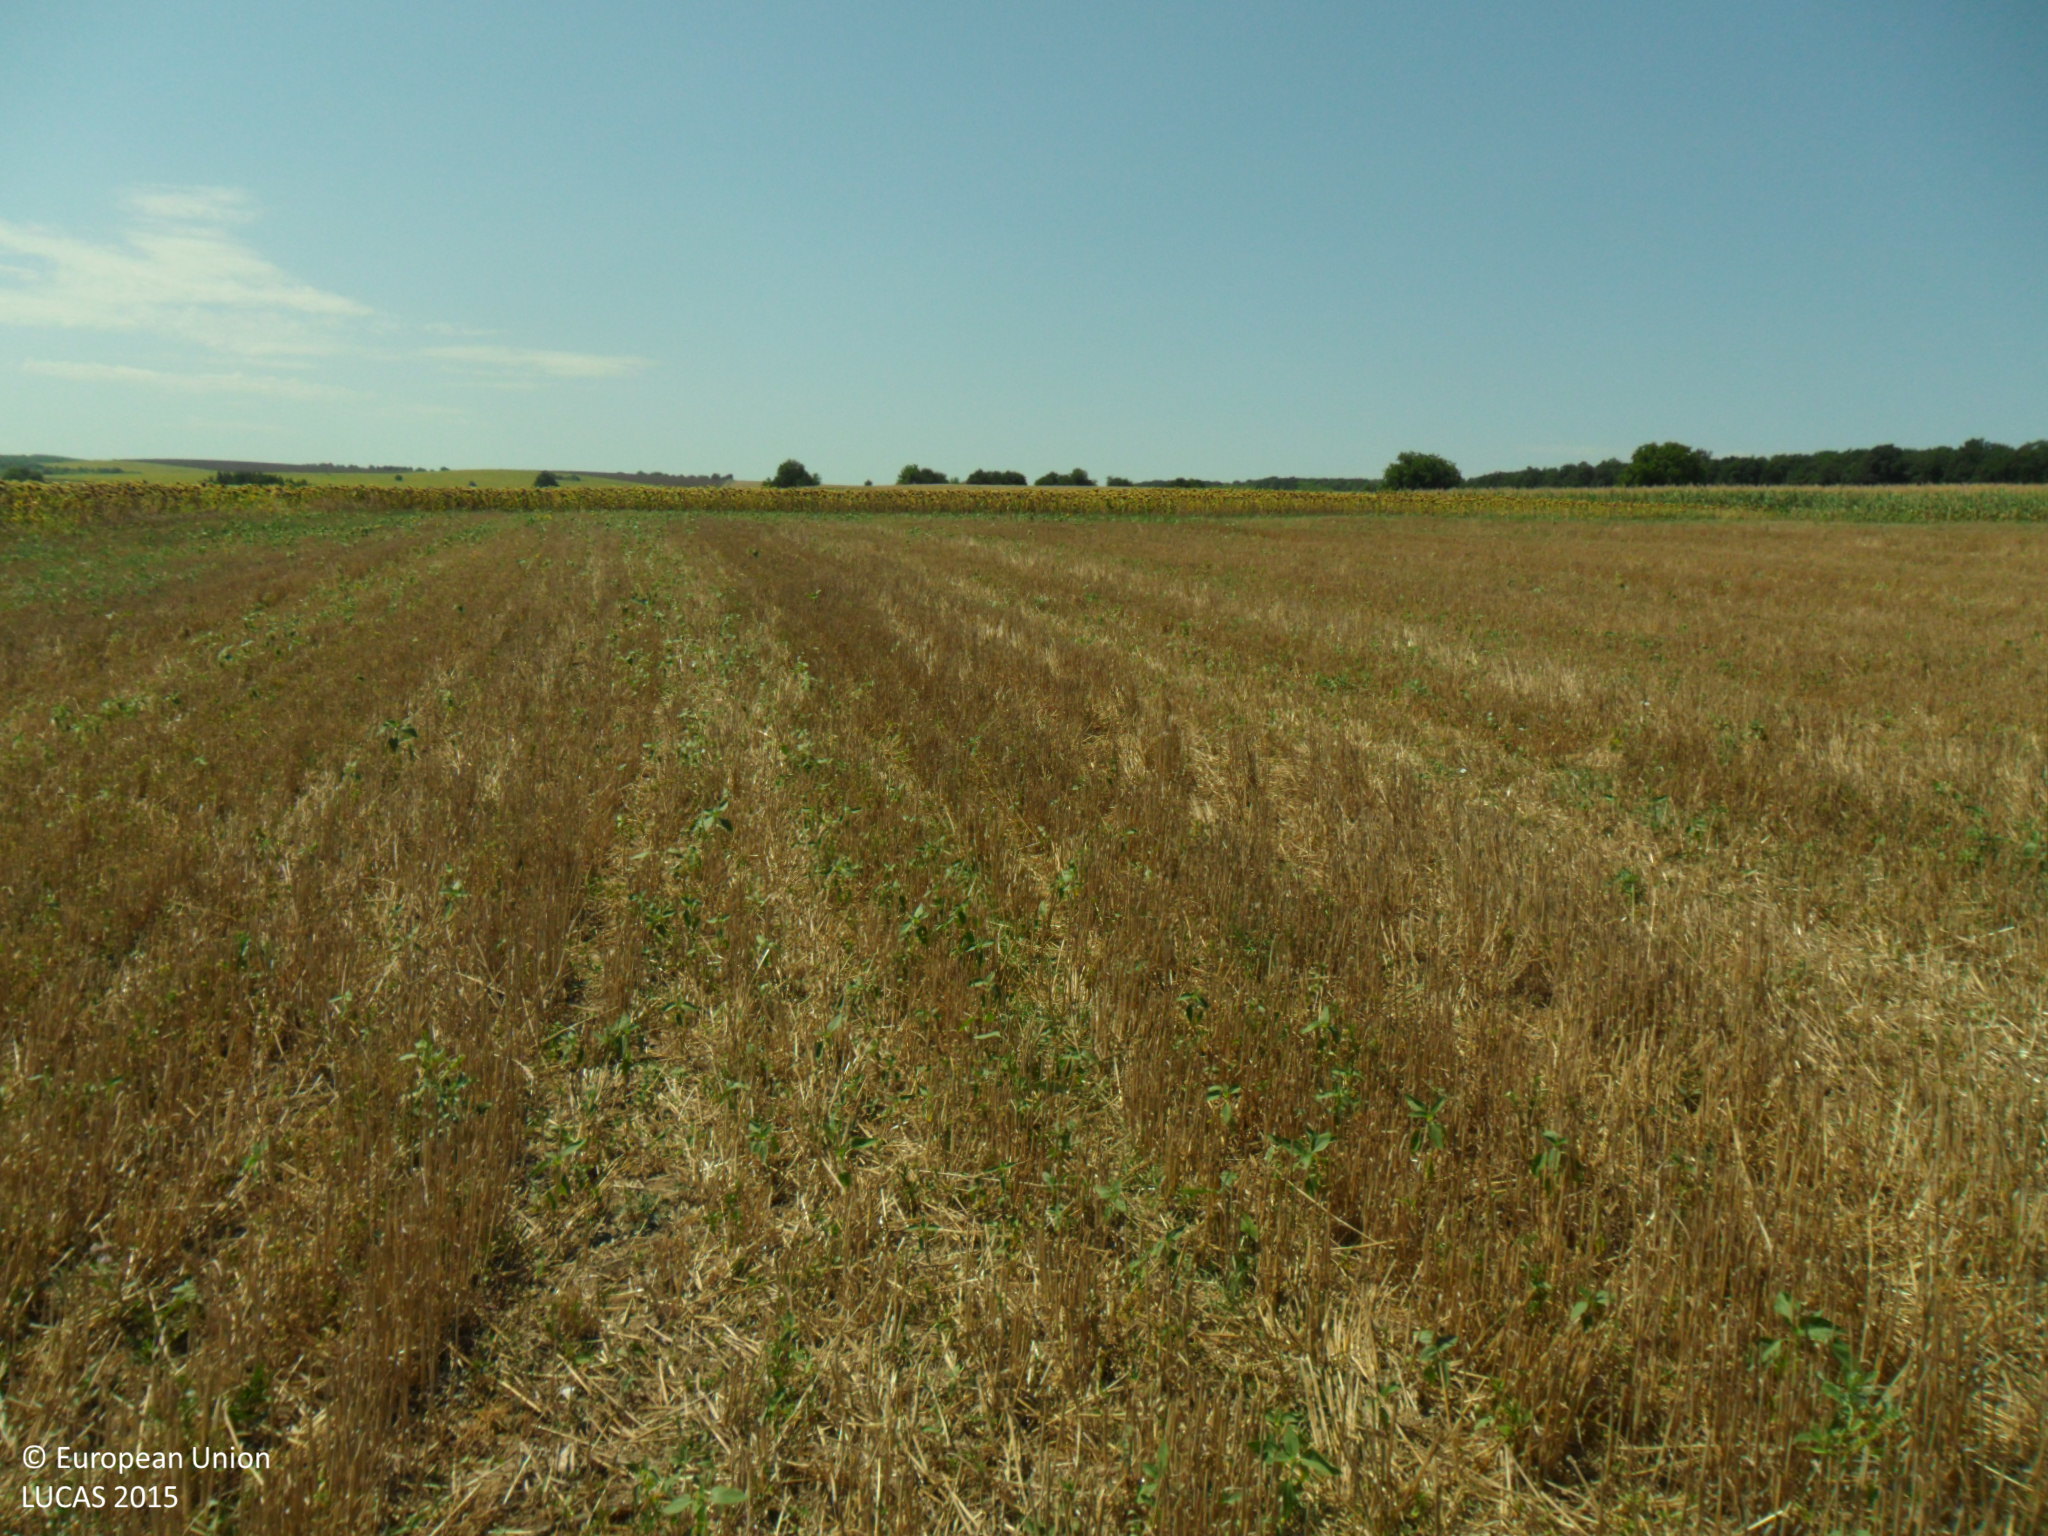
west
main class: Cropland
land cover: Common wheat
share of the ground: 25 - 50 %
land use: Agriculture (excluding fallow land and kitchen gardens)
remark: Harvested field
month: August
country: BG
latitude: 43.5489
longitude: 26.4040
